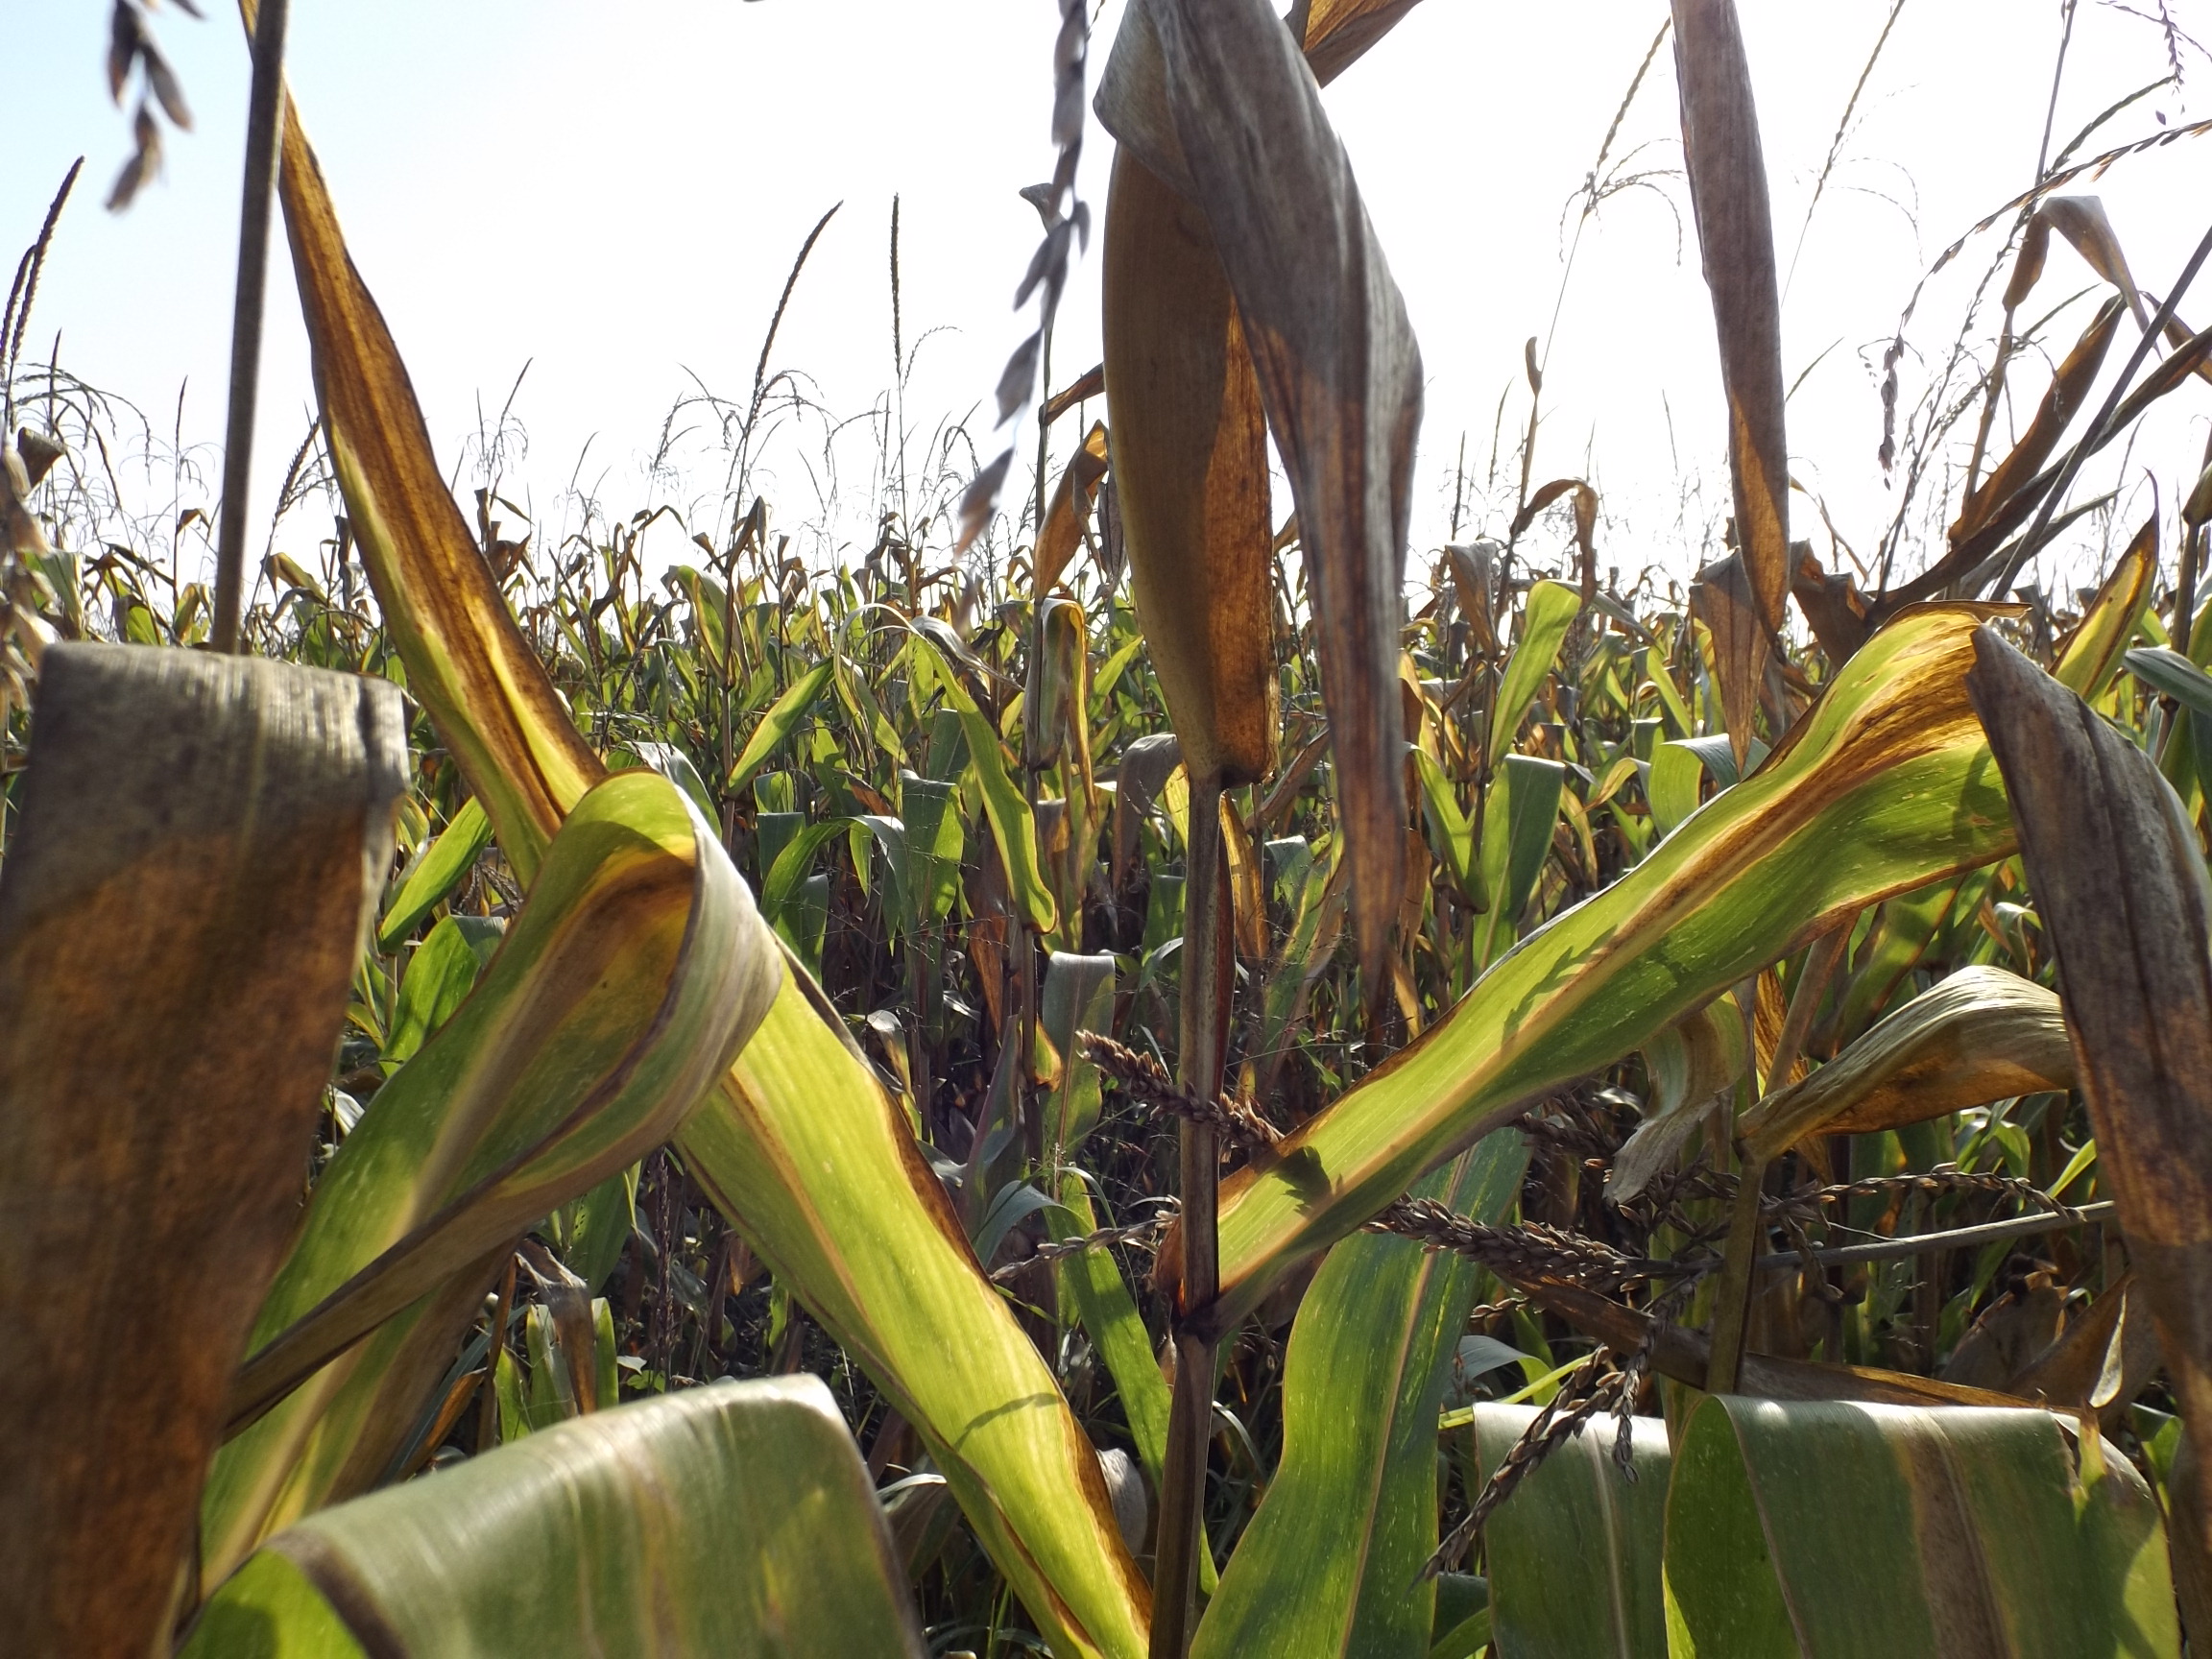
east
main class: Cropland
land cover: Maize
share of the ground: > 75 %
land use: Agriculture (excluding fallow land and kitchen gardens)
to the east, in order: Maize; Tobacco; Grass margins; Tobacco; Tracks; Maize; Spontaneously vegetated surfaces; Maize
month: September
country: BG
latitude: 44.0073
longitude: 26.4096
